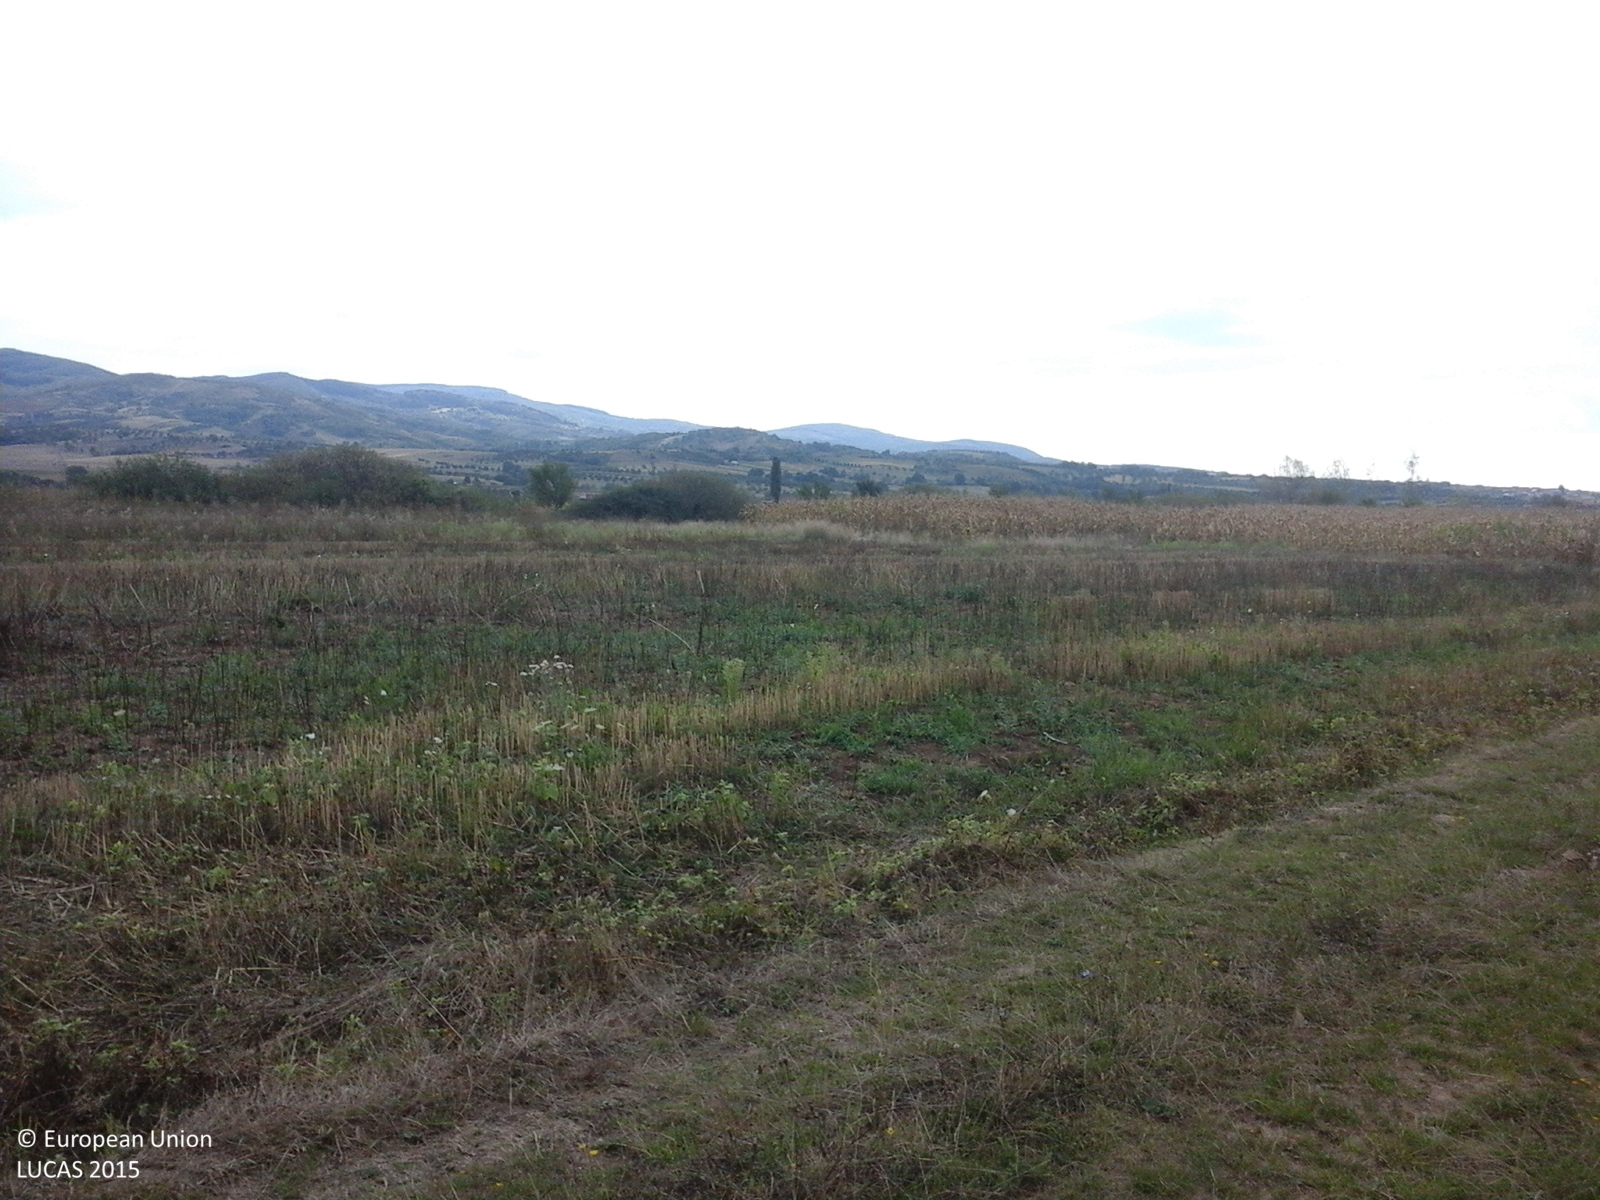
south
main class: Cropland
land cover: Maize
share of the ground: > 75 %
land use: Agriculture (excluding fallow land and kitchen gardens)
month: September
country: RO
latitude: 47.8425
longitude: 23.3686
